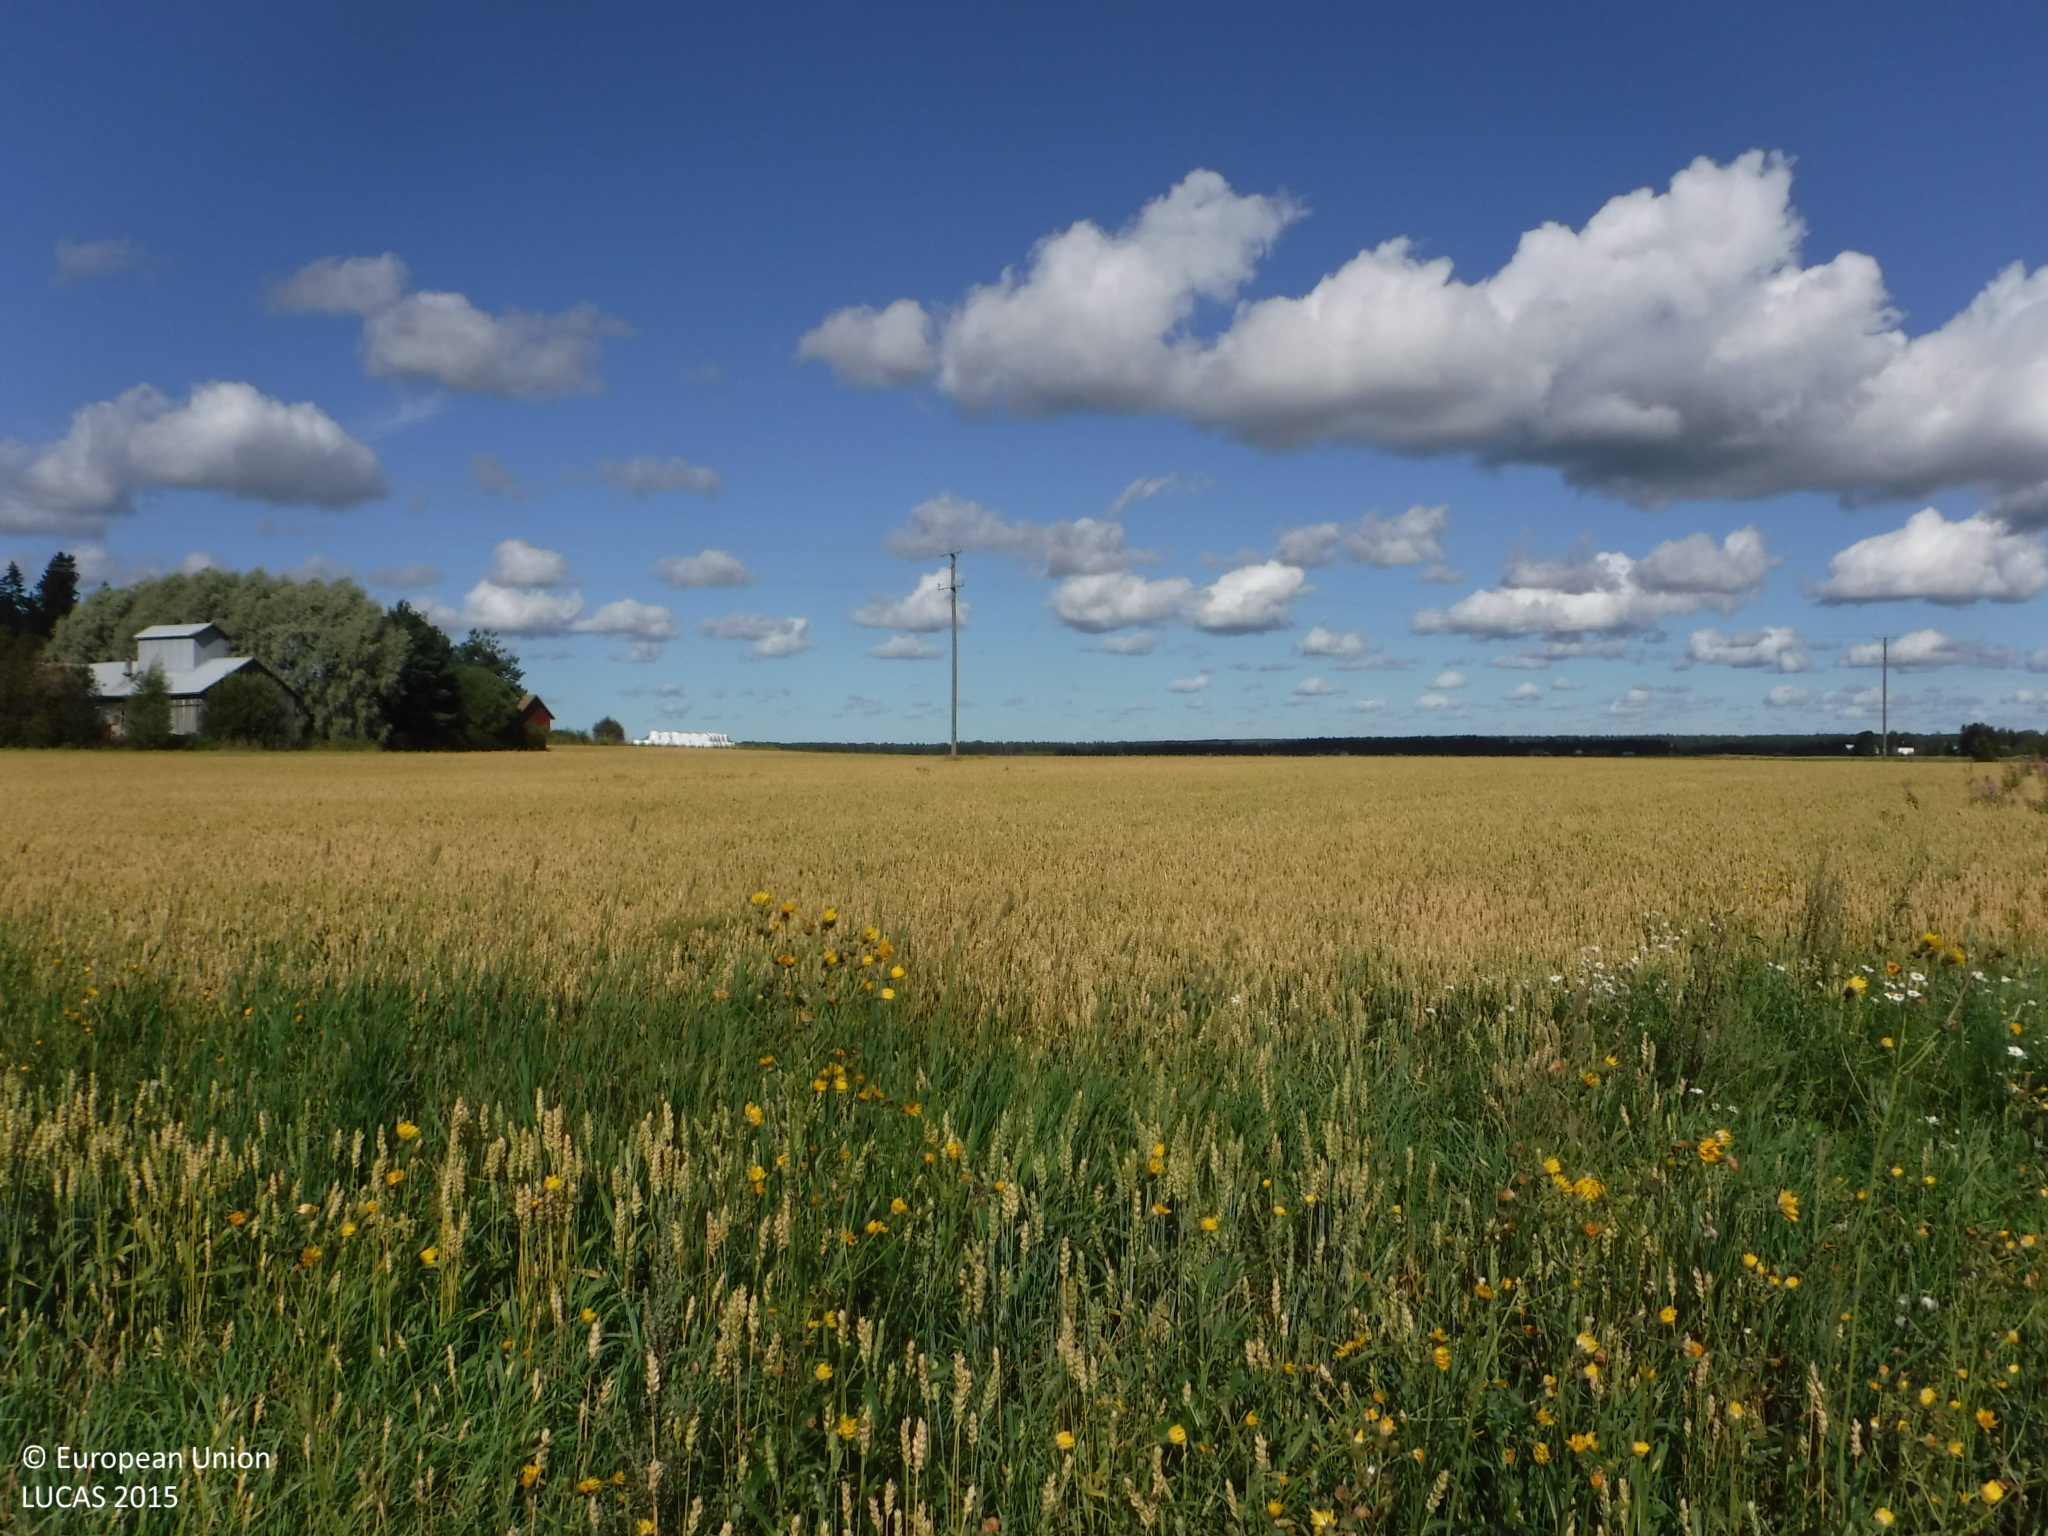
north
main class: Cropland
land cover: Common wheat
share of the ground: > 75 %
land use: Agriculture (excluding fallow land and kitchen gardens)
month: August
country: FI
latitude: 61.2239
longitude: 21.9196
